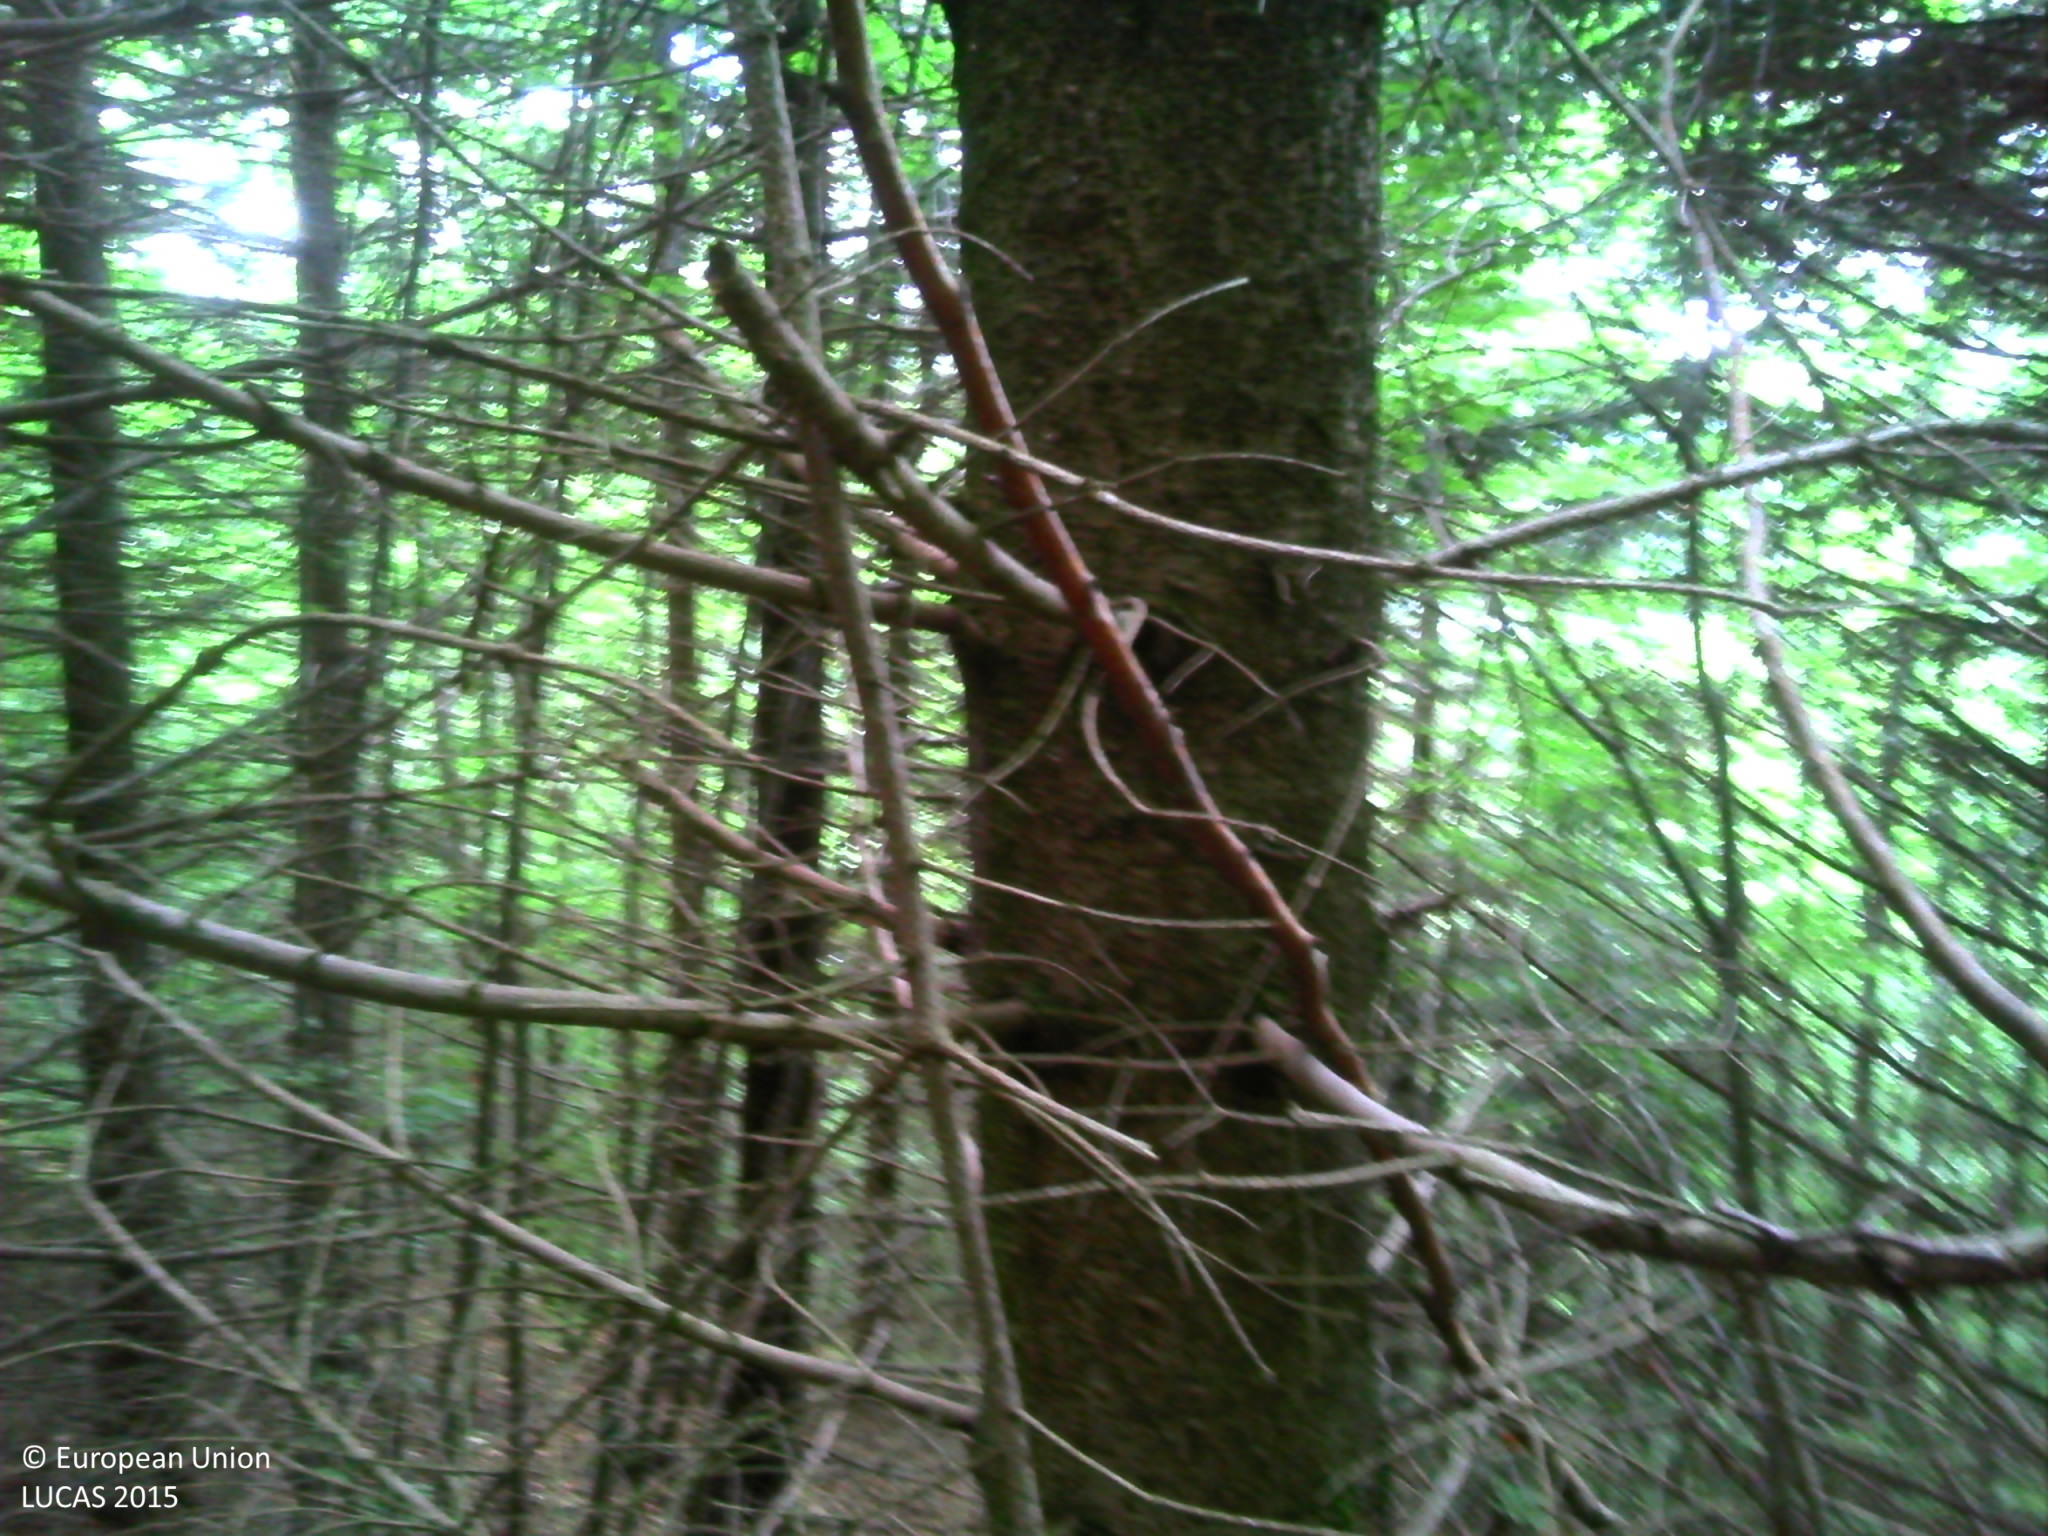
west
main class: Woodland
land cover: Other mixed woodland
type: mountainous beech forest
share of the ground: > 75 %
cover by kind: coniferous forest trees 65 %, broadleaved forest trees 35 %
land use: Forestry
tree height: > 5 m
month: June
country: FR
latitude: 44.6032
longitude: 3.8698
